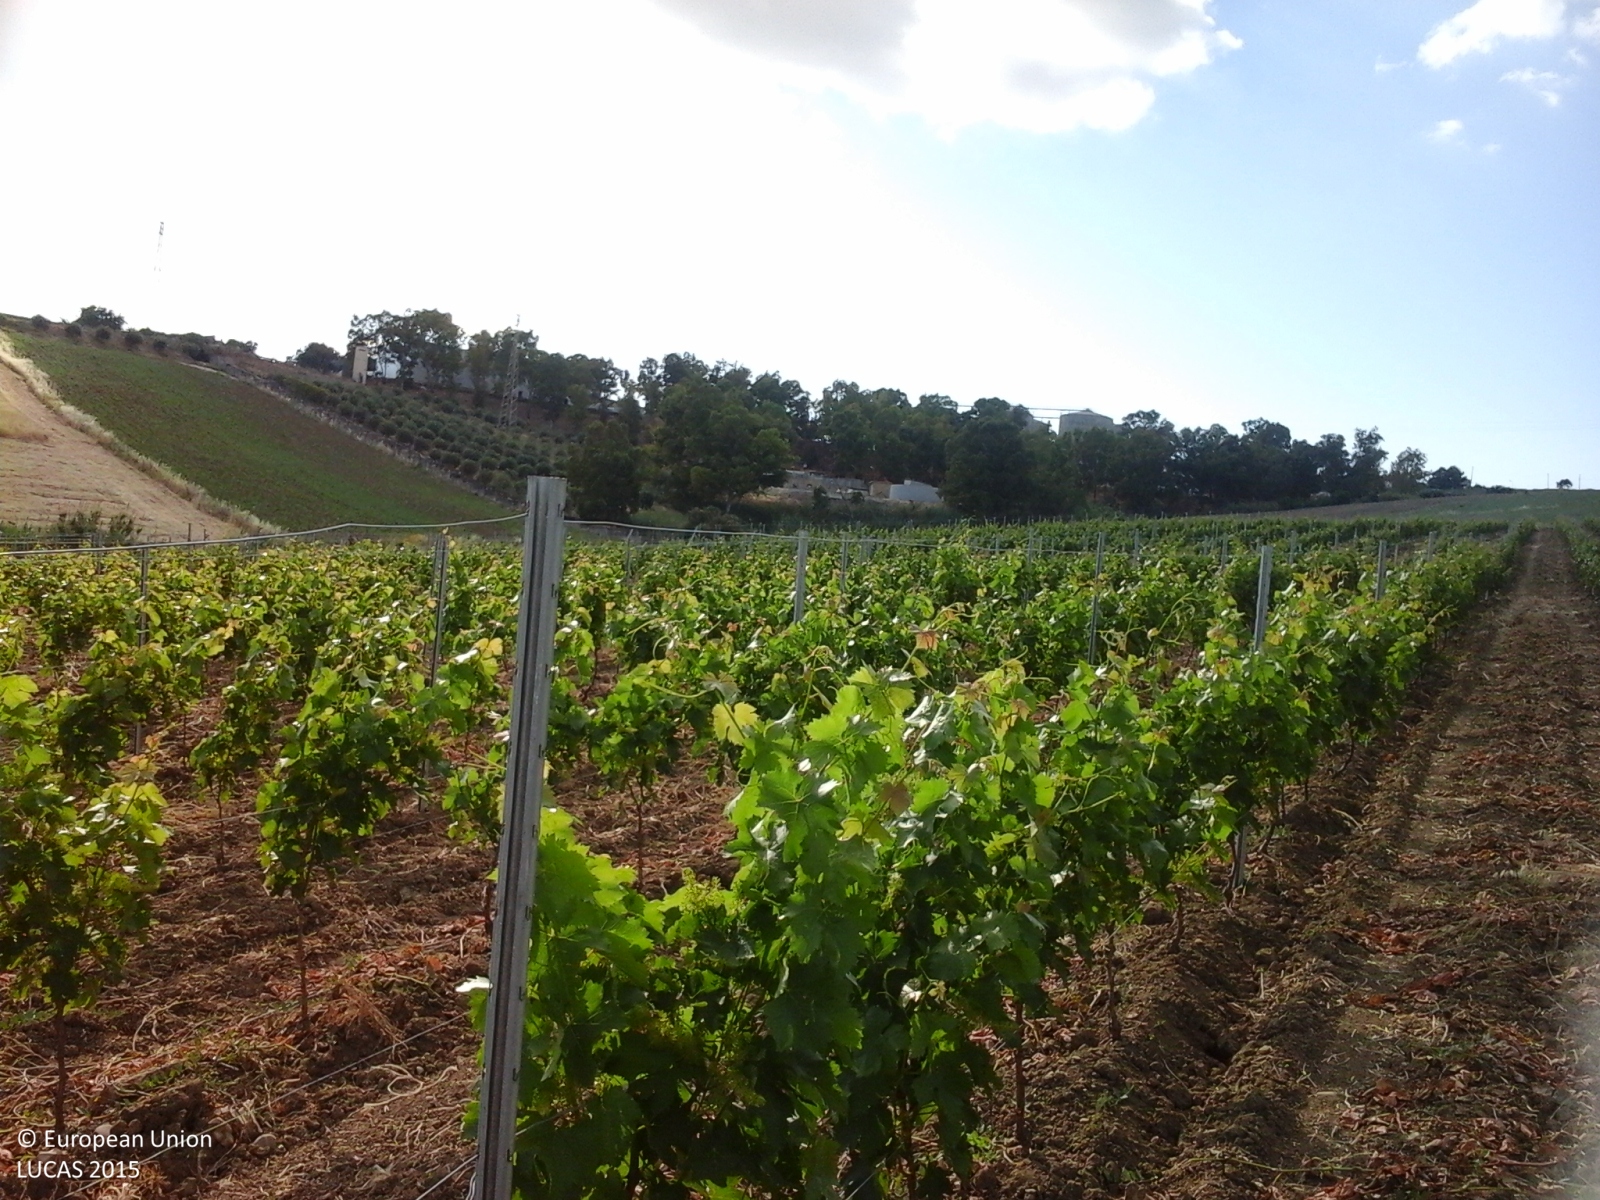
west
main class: Cropland
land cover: Vineyards
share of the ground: 10 - 25 %
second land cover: Other bare soil
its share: > 75 %
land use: Agriculture (excluding fallow land and kitchen gardens)
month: May
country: IT
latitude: 37.5919
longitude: 12.9785
